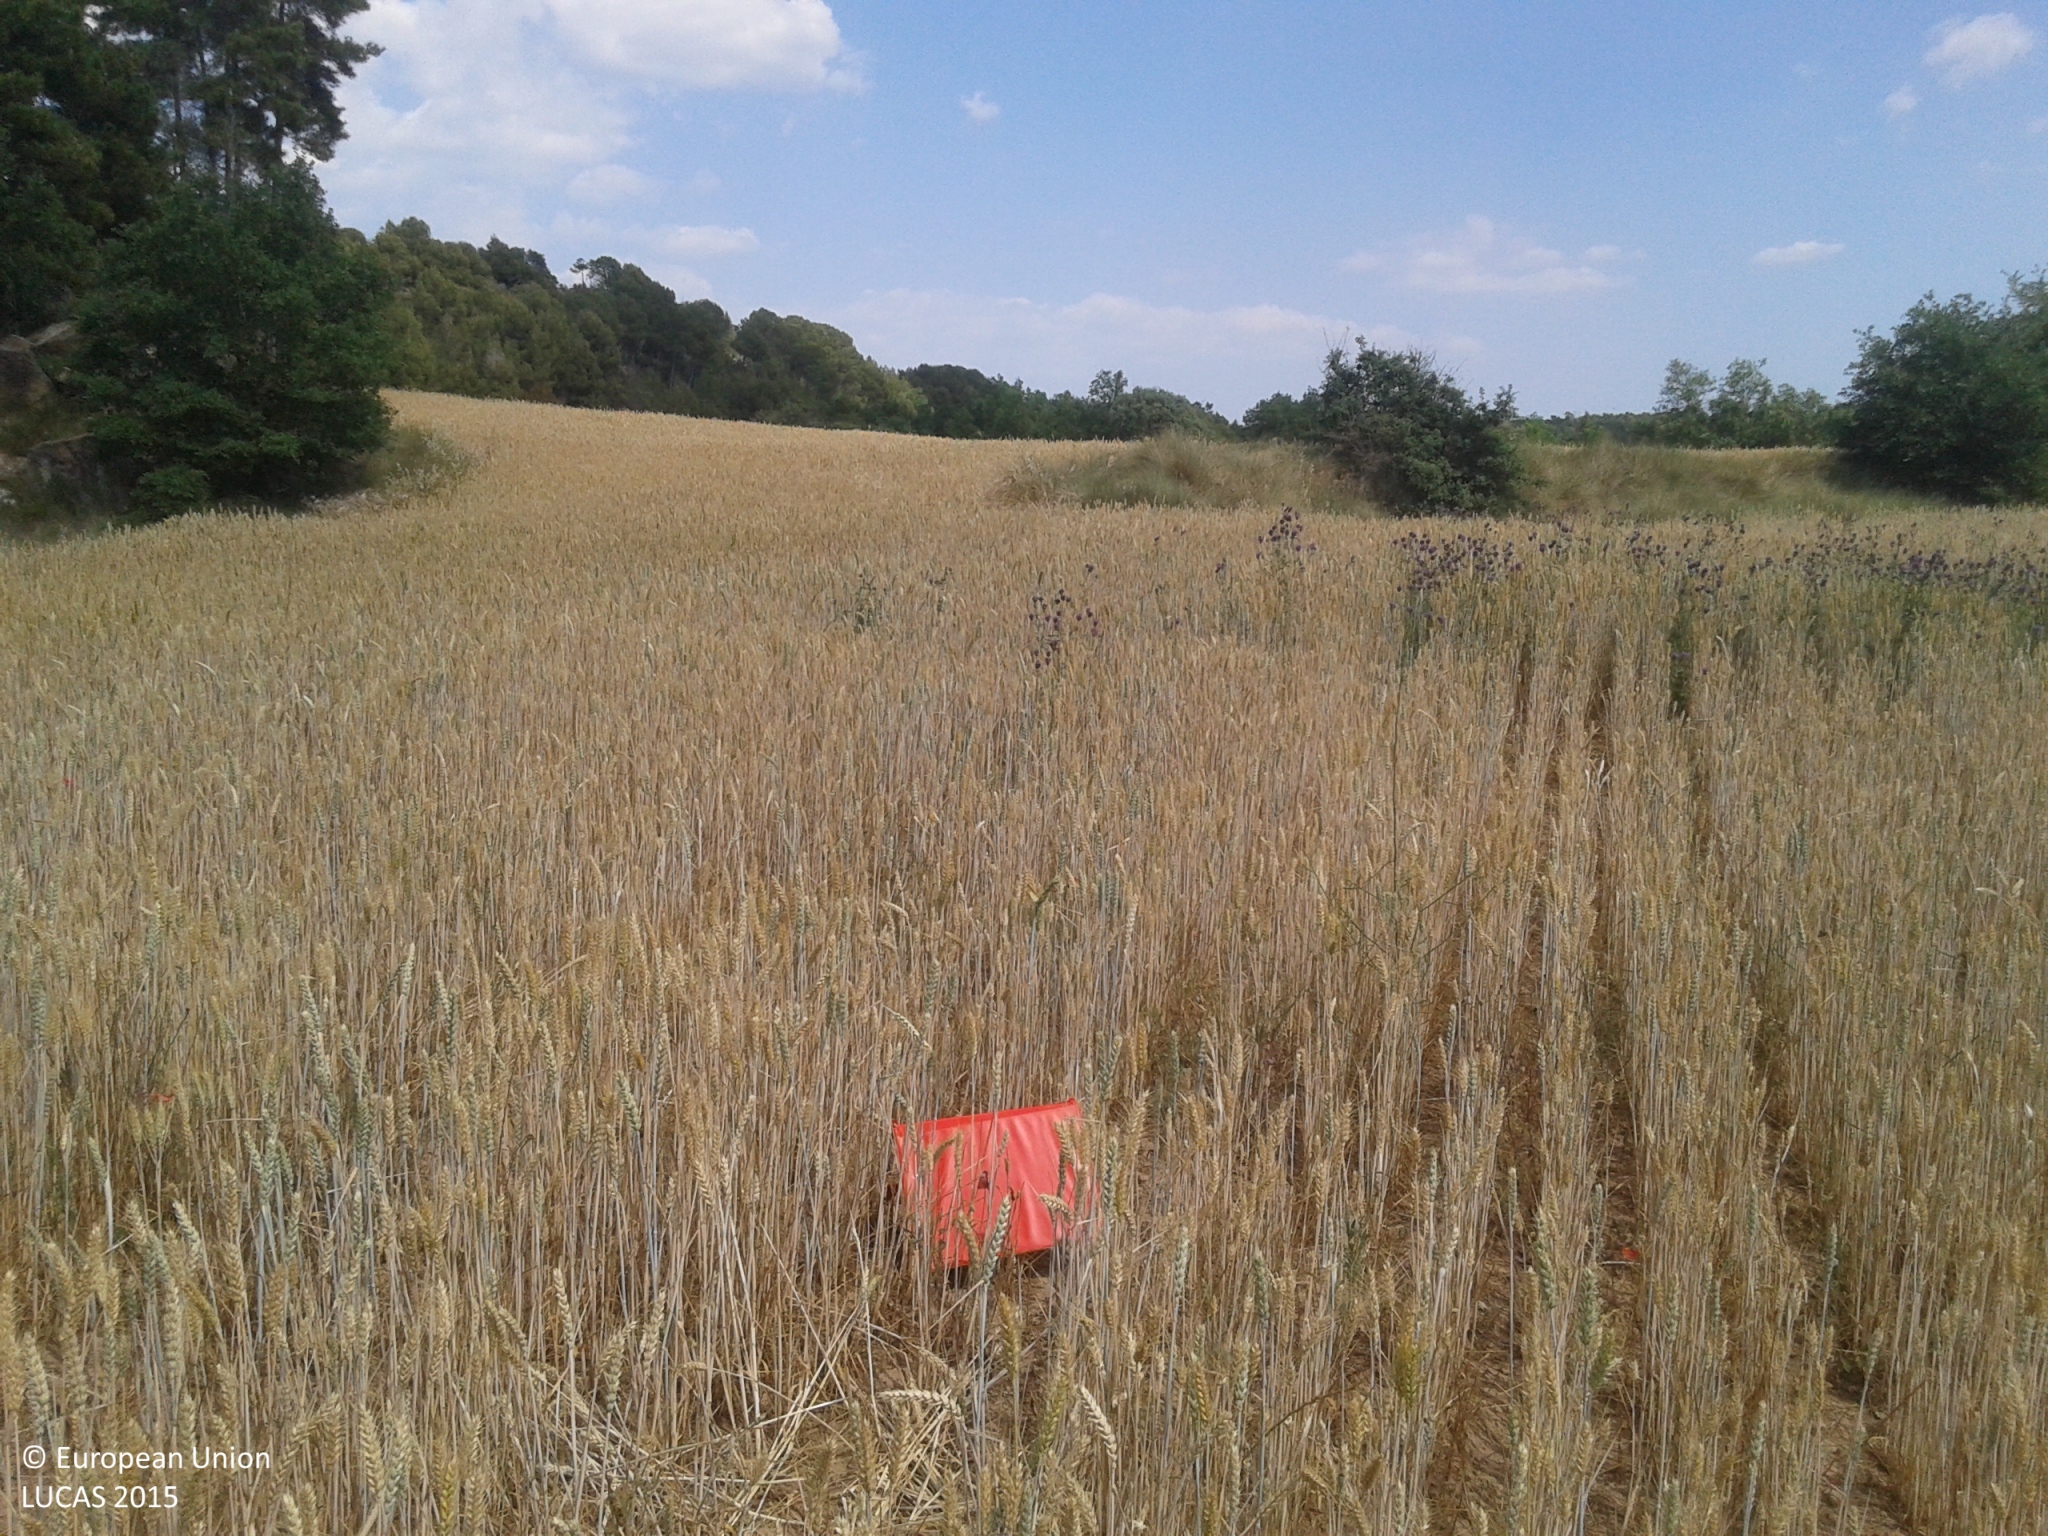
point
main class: Cropland
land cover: Common wheat
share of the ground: > 75 %
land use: Agriculture (excluding fallow land and kitchen gardens)
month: June
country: ES
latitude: 41.9580
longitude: 1.5796
